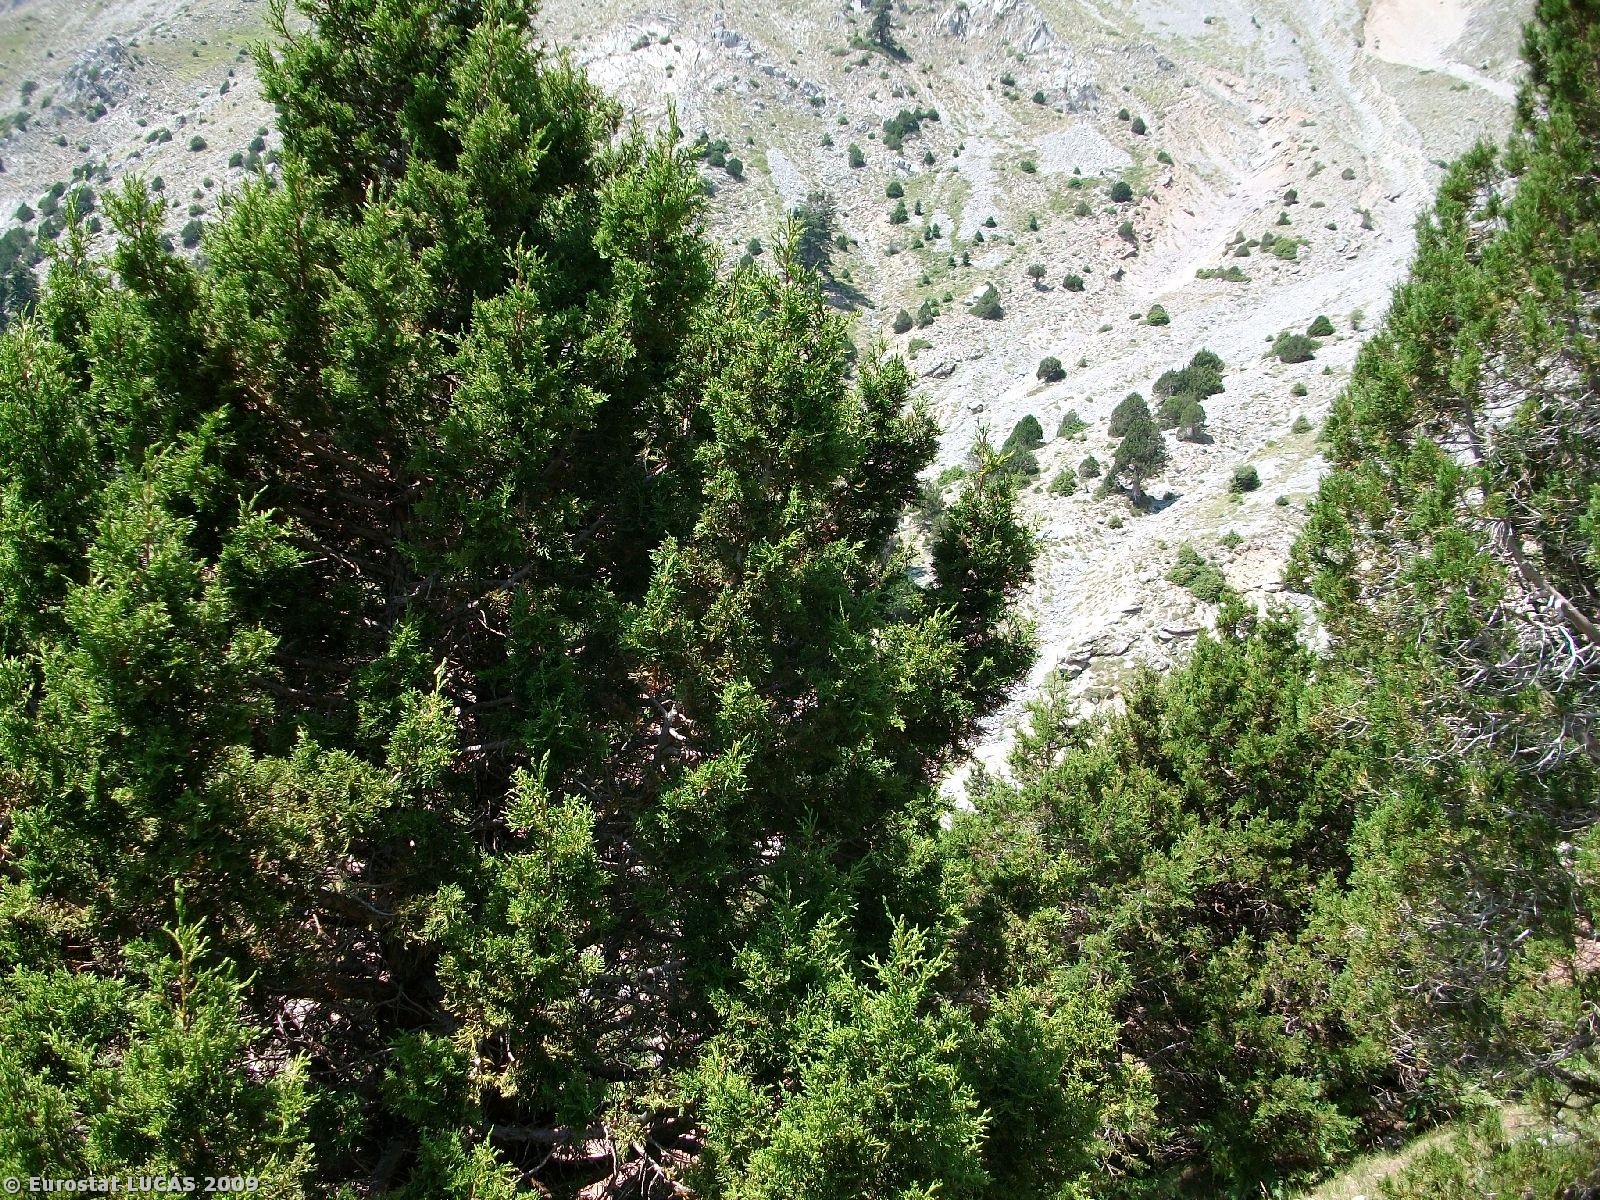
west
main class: Shrubland
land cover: Shrubland with sparse tree cover
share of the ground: 50 - 75 %
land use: Unused
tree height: > 5 m
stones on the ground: < 10 %
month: August
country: GR
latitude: 39.1048
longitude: 21.5752
